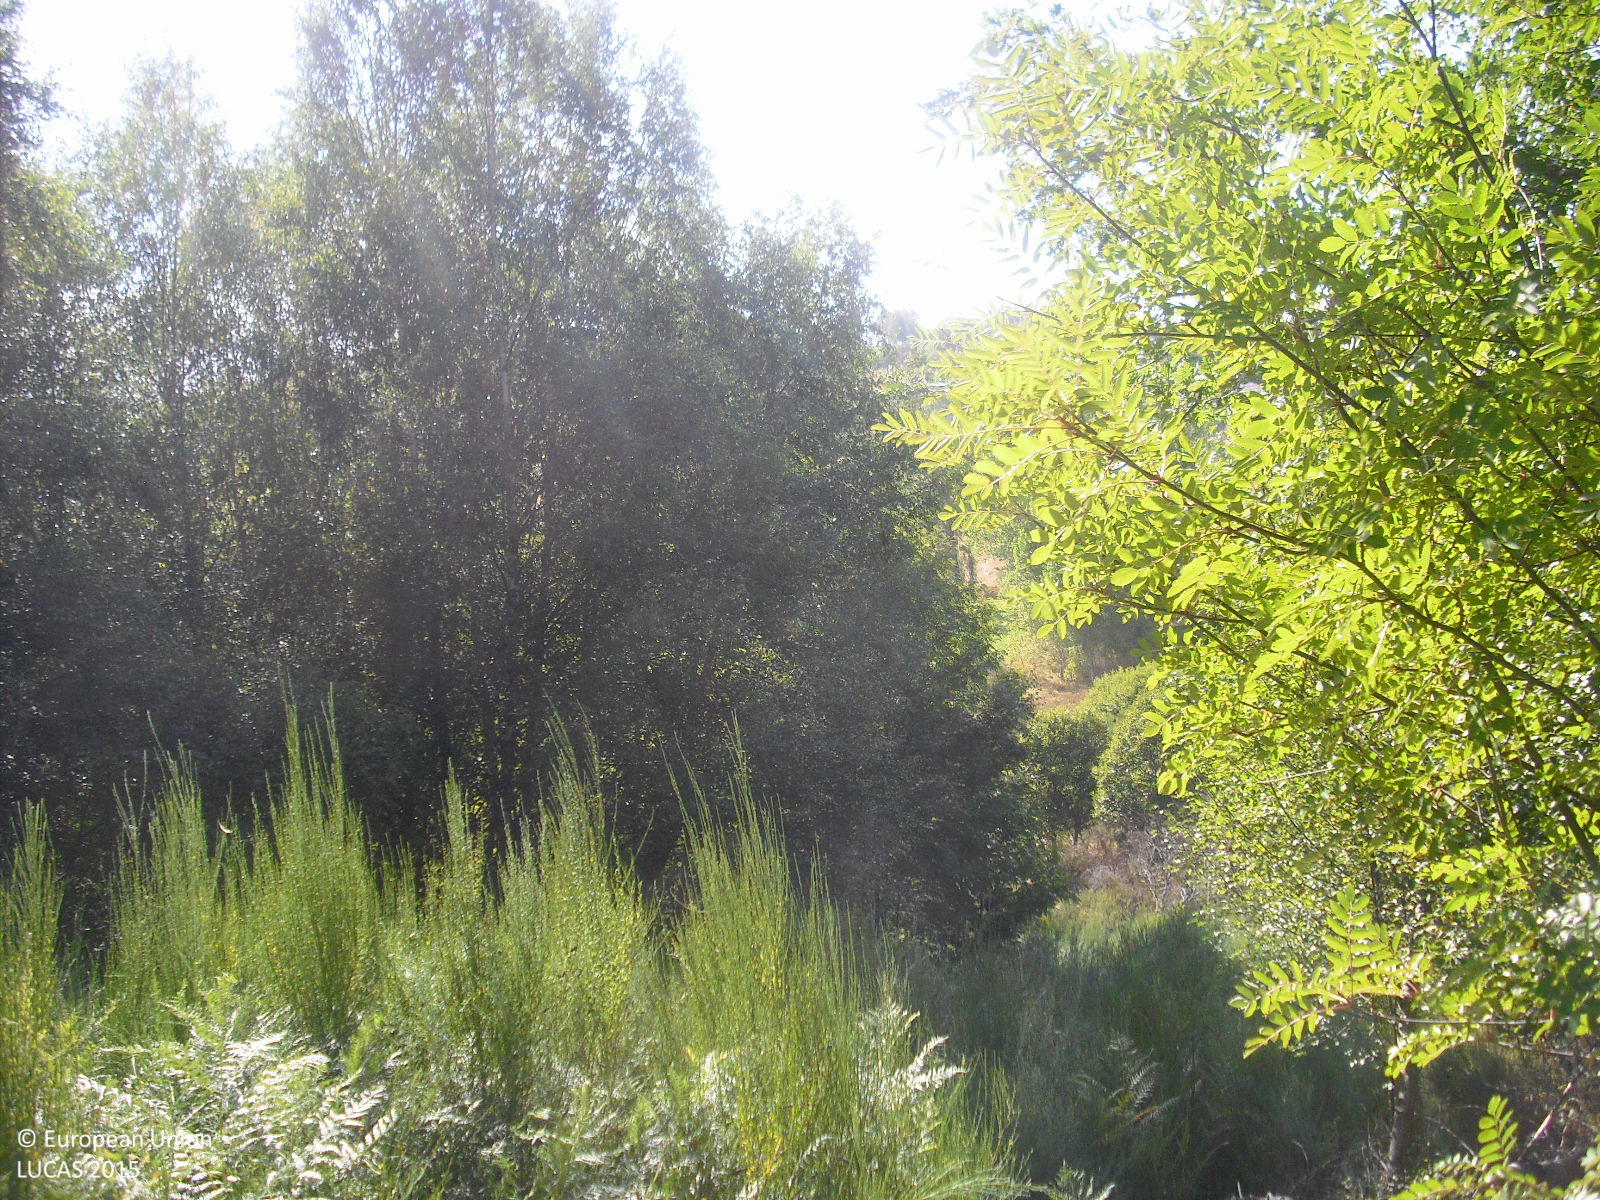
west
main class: Woodland
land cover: Broadleaved woodland
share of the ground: 50 - 75 %
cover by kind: broadleaved forest trees 70 %, shrubs 30 %
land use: Semi-natural and natural areas not in use
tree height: > 5 m
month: August
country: ES
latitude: 42.1126
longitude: -7.3920
